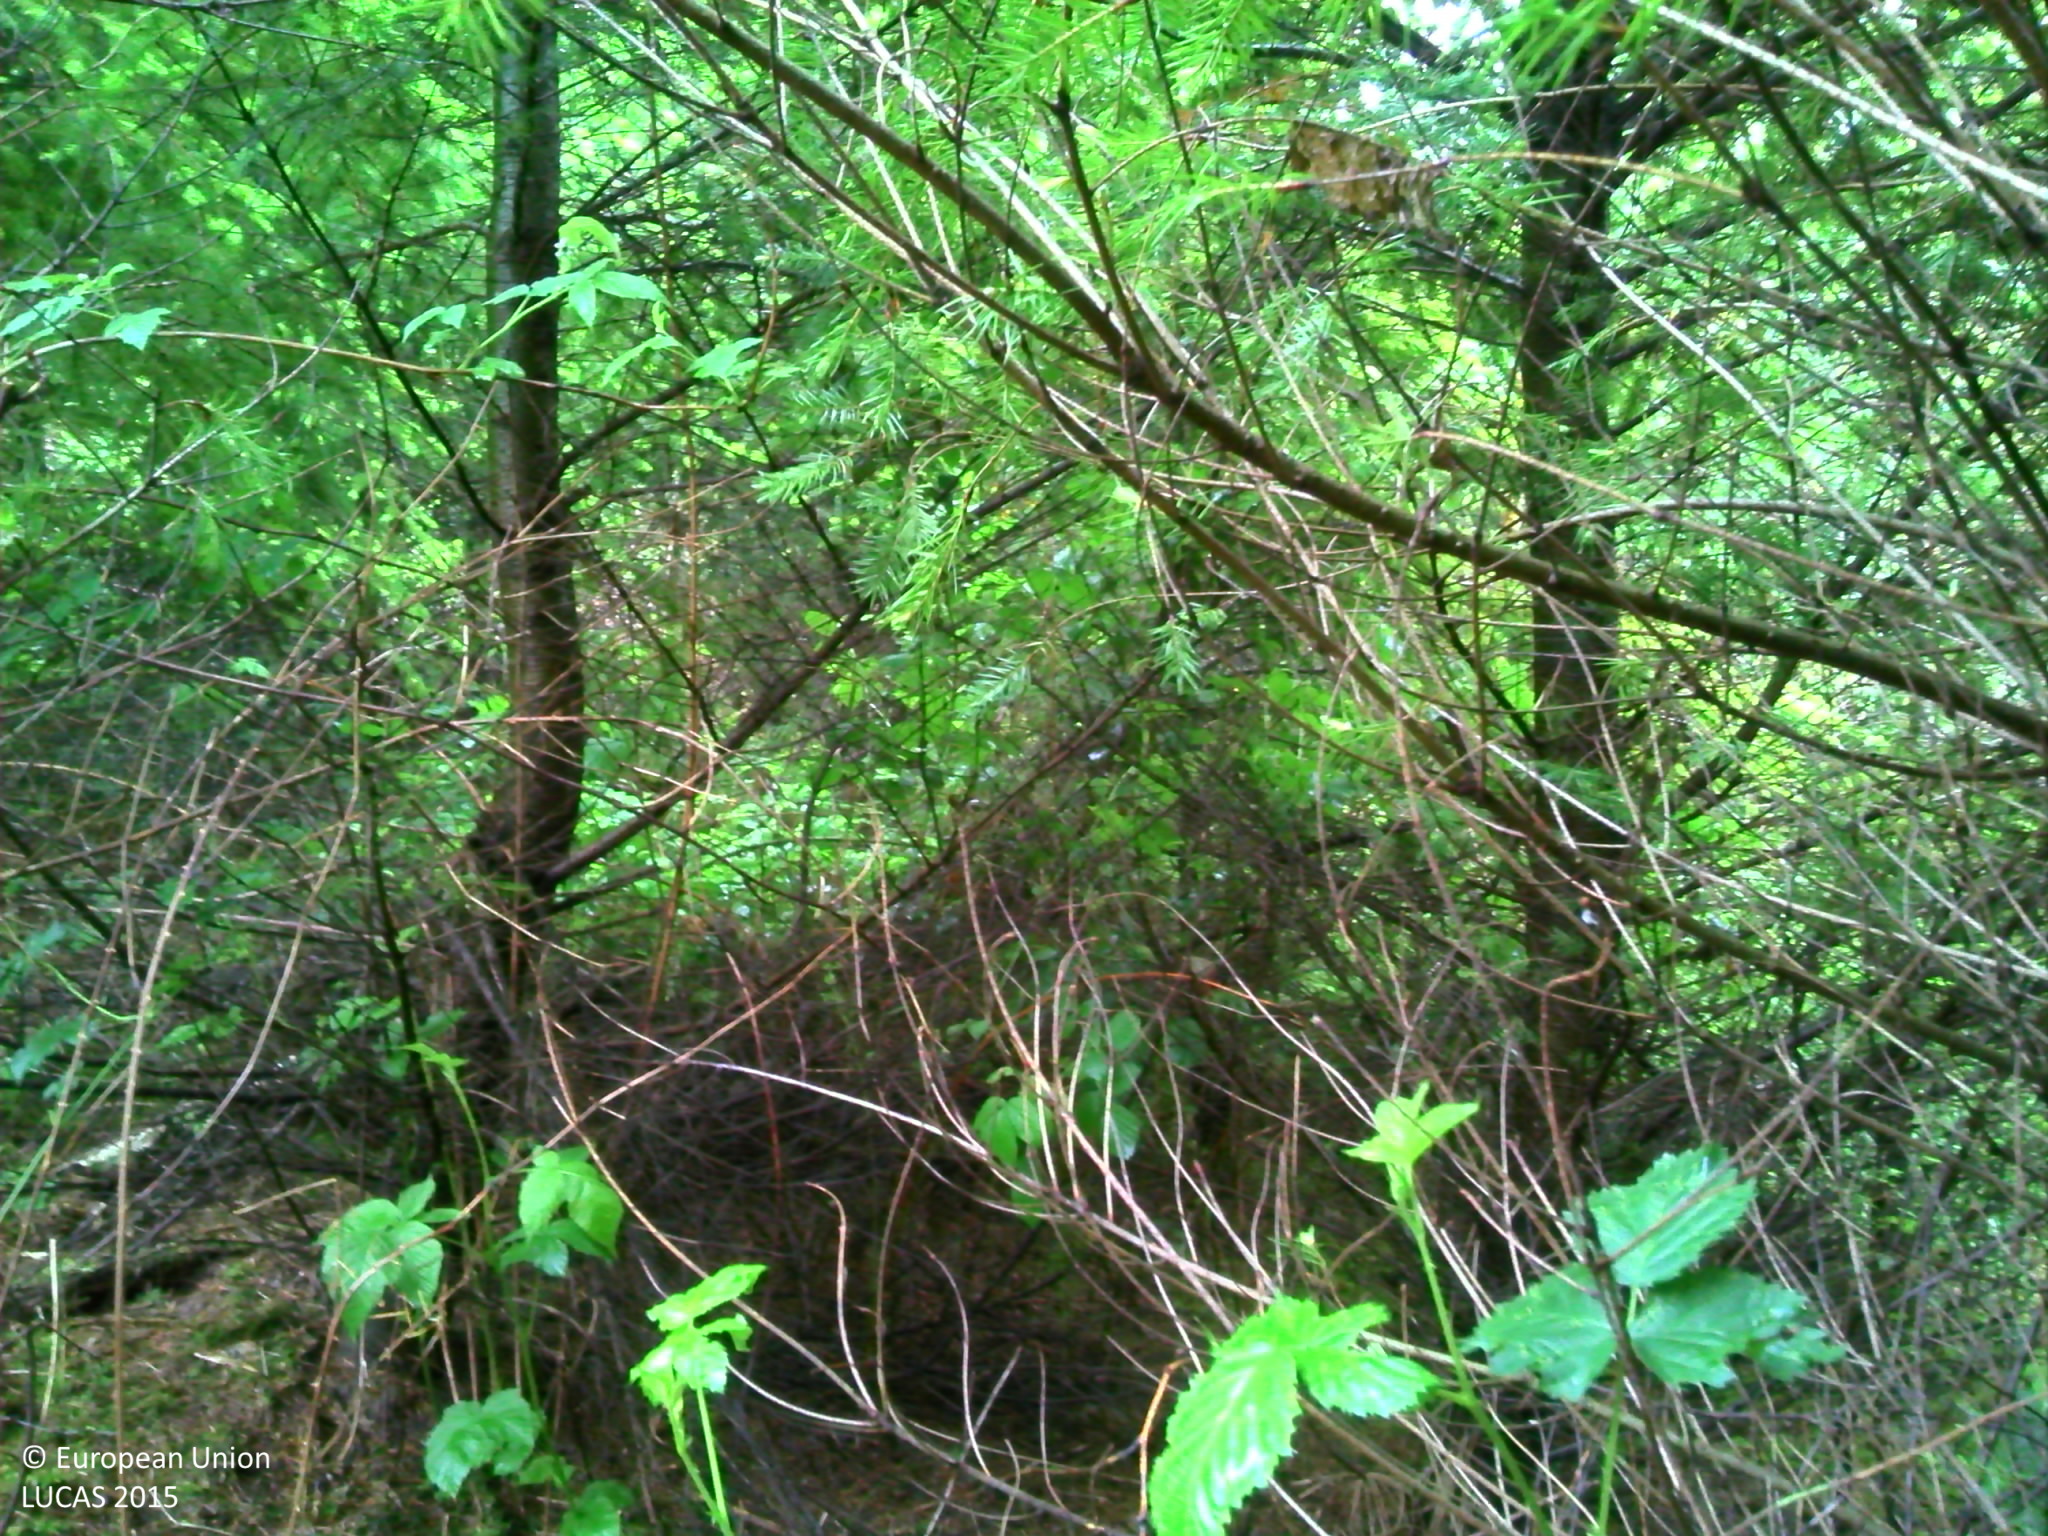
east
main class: Woodland
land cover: Other coniferous woodland
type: exotic forest
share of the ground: > 75 %
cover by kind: coniferous forest trees 85 %, broadleaved forest trees 10 %, lichens and mosses 5 %
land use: Forestry
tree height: > 5 m
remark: Burnt area
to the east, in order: Other coniferous woodland; Spontaneously vegetated surfaces; Other coniferous woodland; Broadleaved woodland; Other coniferous woodland; Spontaneously vegetated surfaces; Other coniferous woodland; Spontaneously vegetated surfaces; Other coniferous woodland; Spontaneously vegetated surfaces; Other coniferous woodland
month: June
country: BE
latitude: 50.3388
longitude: 5.7414
